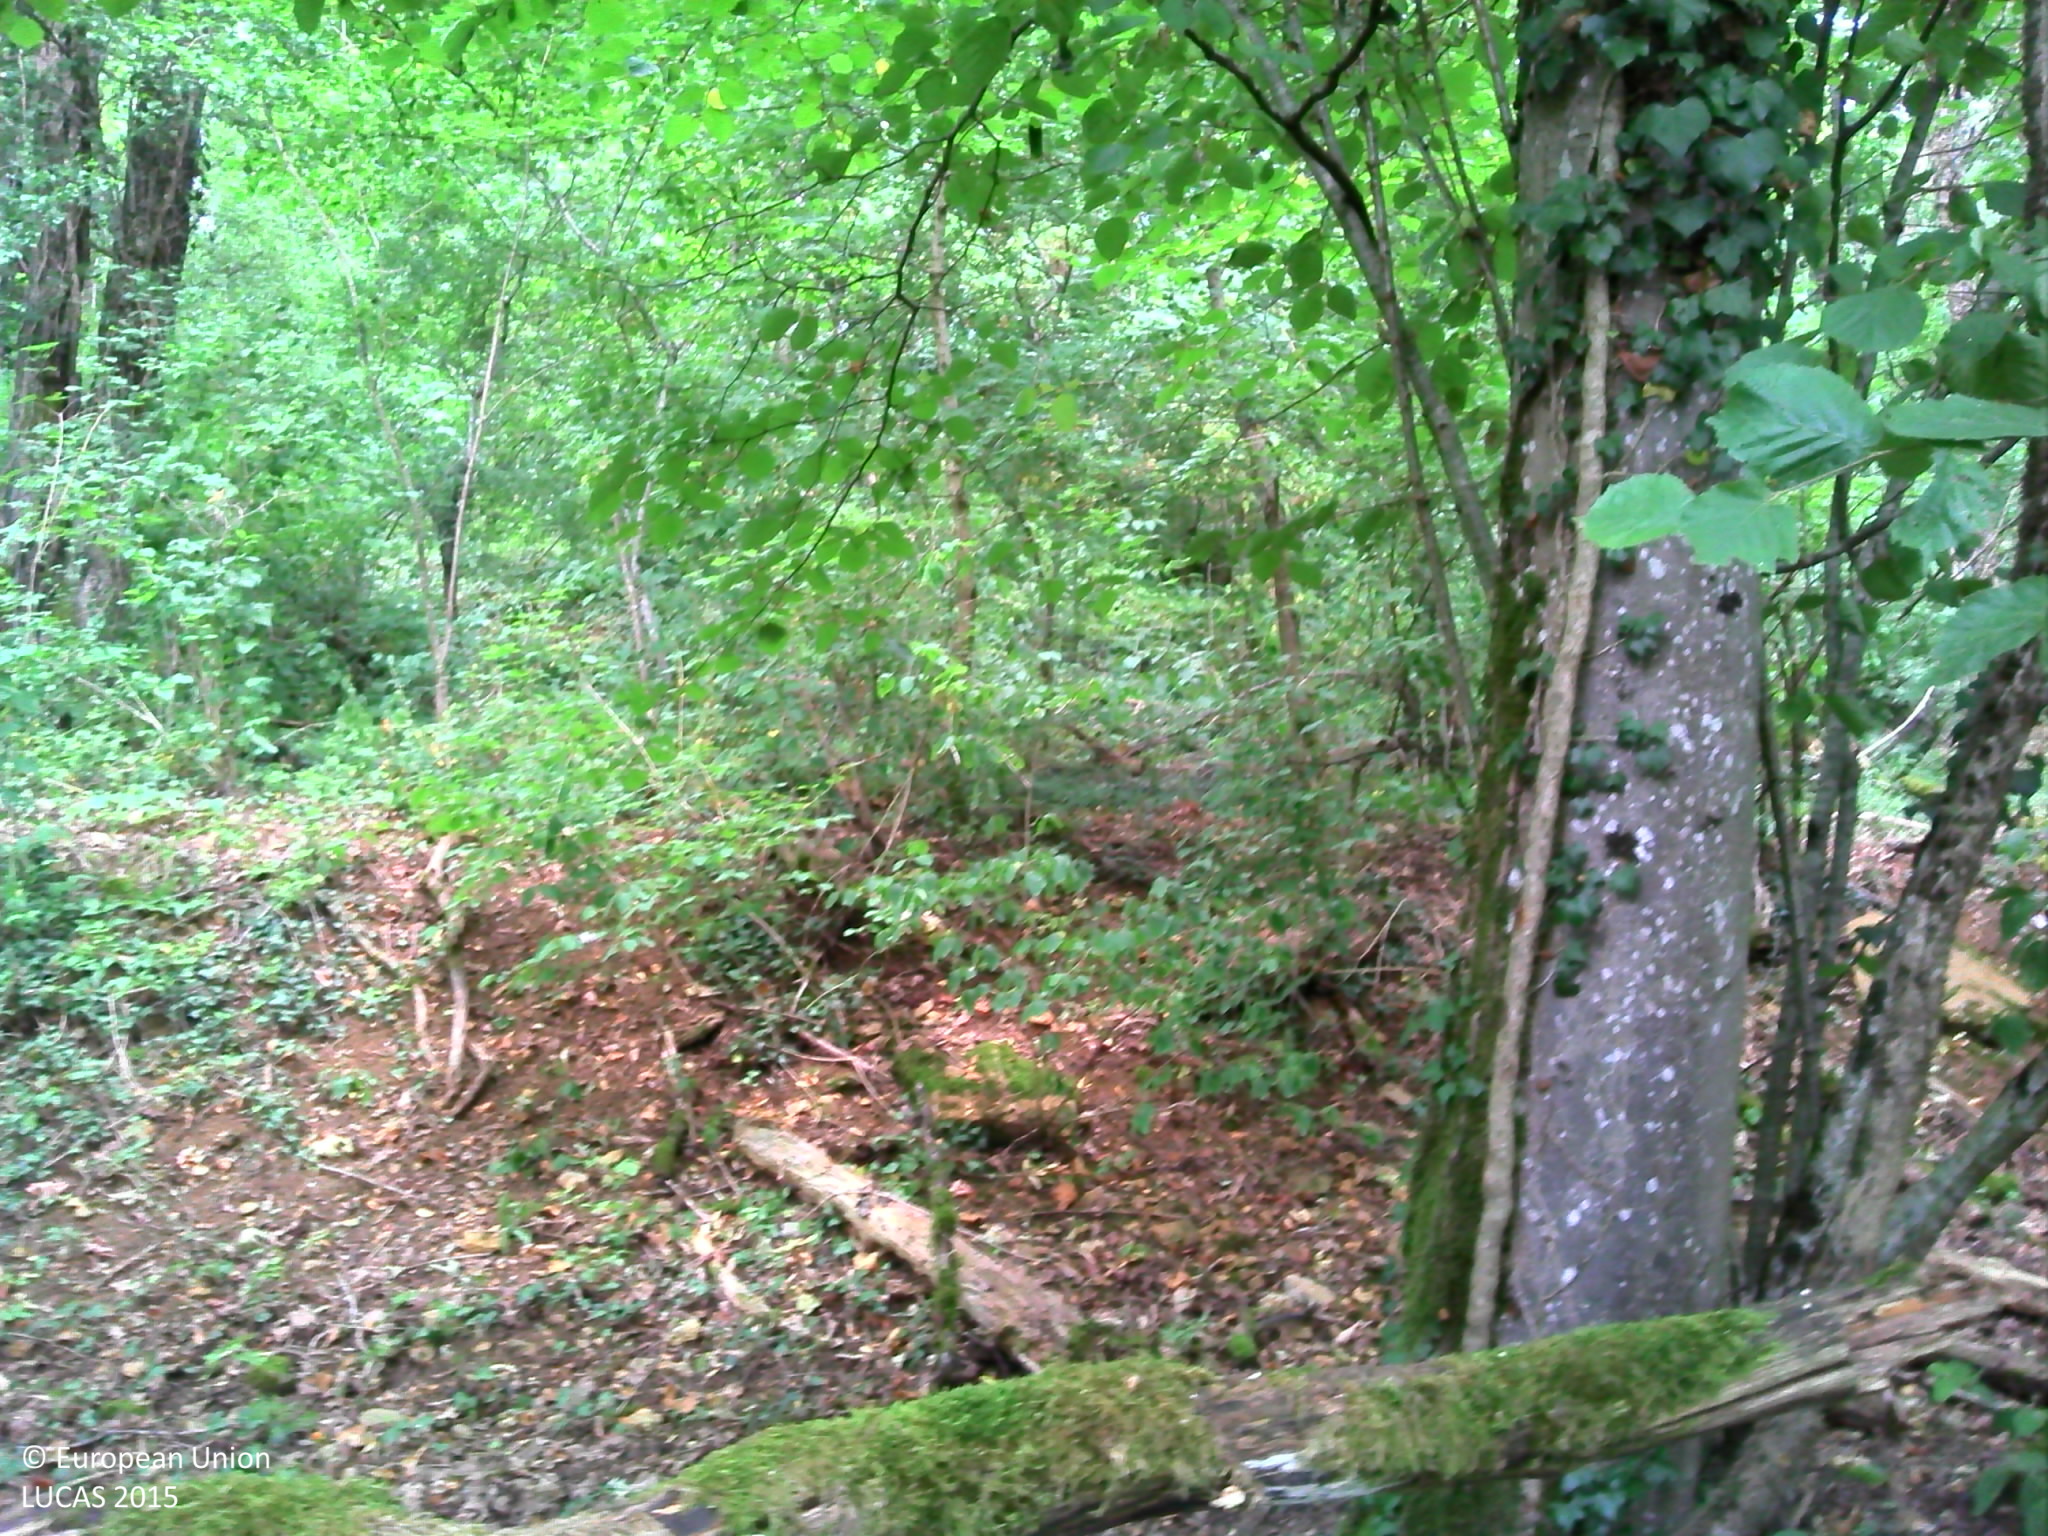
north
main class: Woodland
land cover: Broadleaved woodland
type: acidophilous oak and oak-birch forest
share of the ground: > 75 %
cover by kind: broadleaved forest trees 80 %, herbaceous plants 10 %, lichens and mosses 10 %
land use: Agriculture (excluding fallow land and kitchen gardens)
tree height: > 5 m
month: July
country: FR
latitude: 47.9645
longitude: 5.3791
